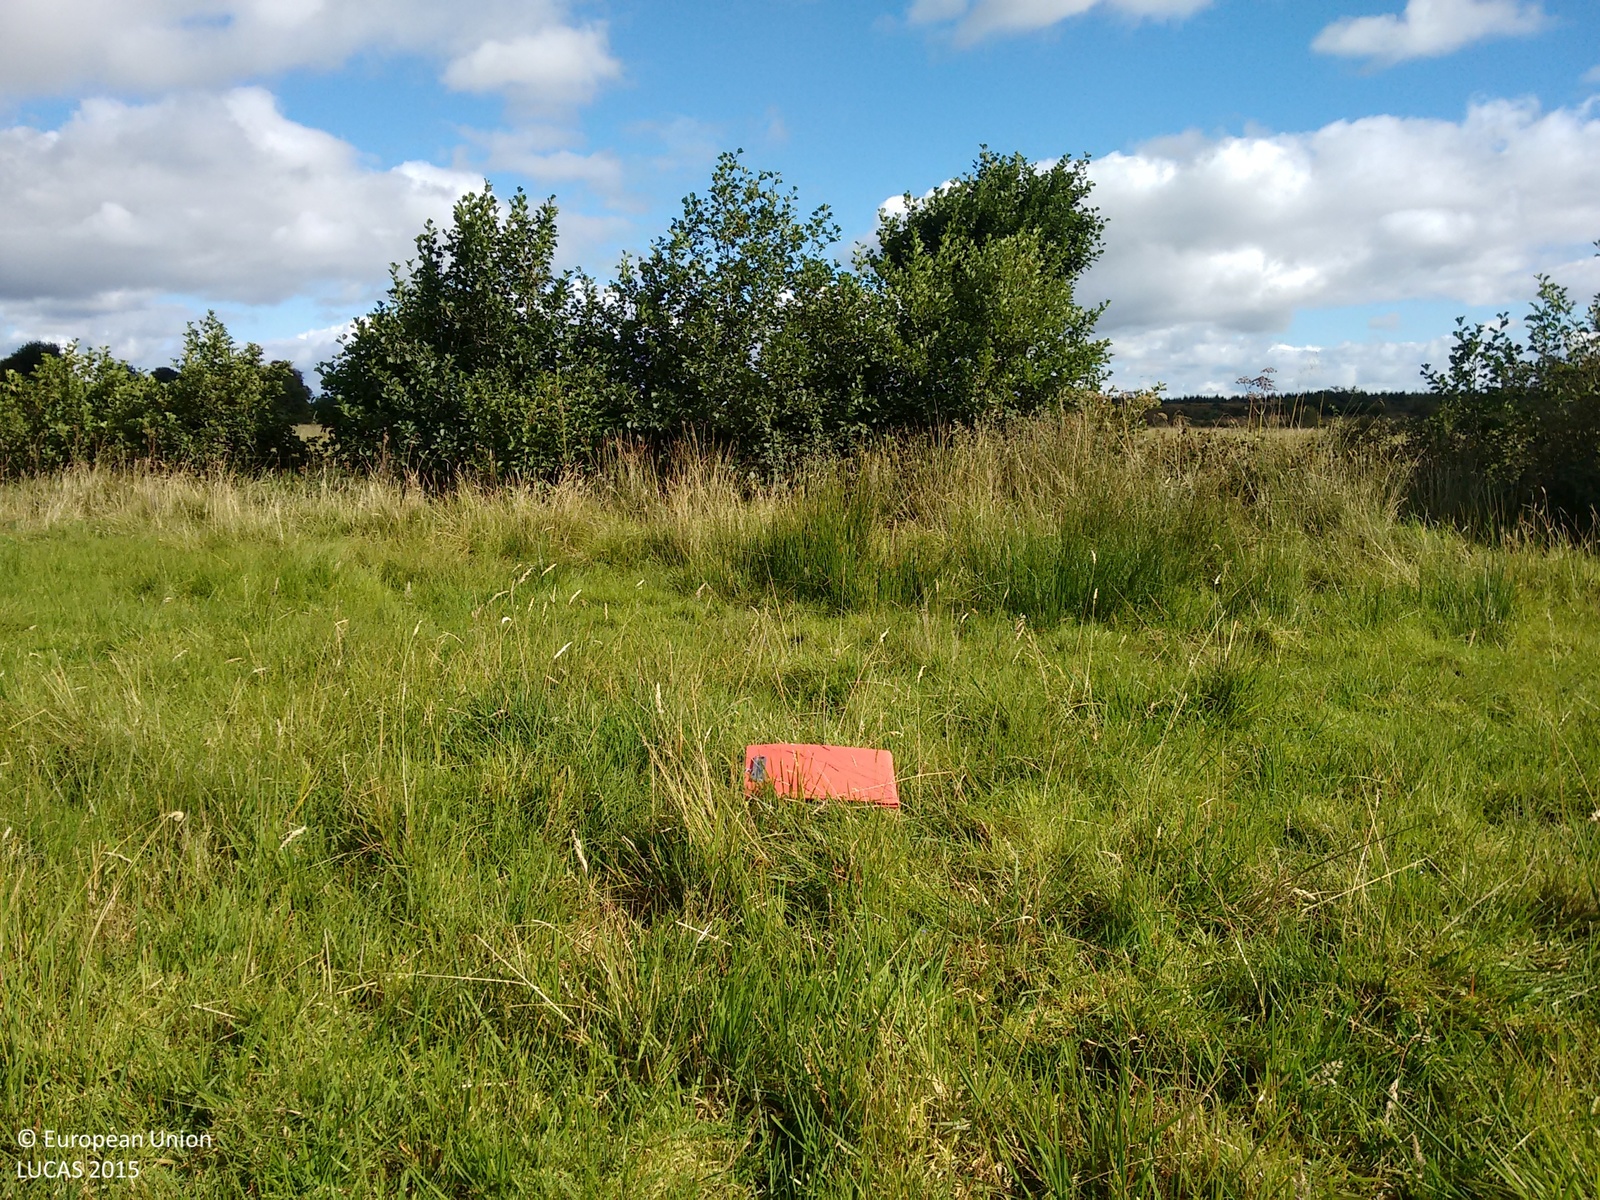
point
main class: Grassland
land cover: Grassland without tree/shrub cover
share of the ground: > 75 %
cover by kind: herbaceous plants 100 %
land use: Agriculture (excluding fallow land and kitchen gardens)
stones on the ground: < 10 %
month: September
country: IE
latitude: 53.7257
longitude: -8.8955
